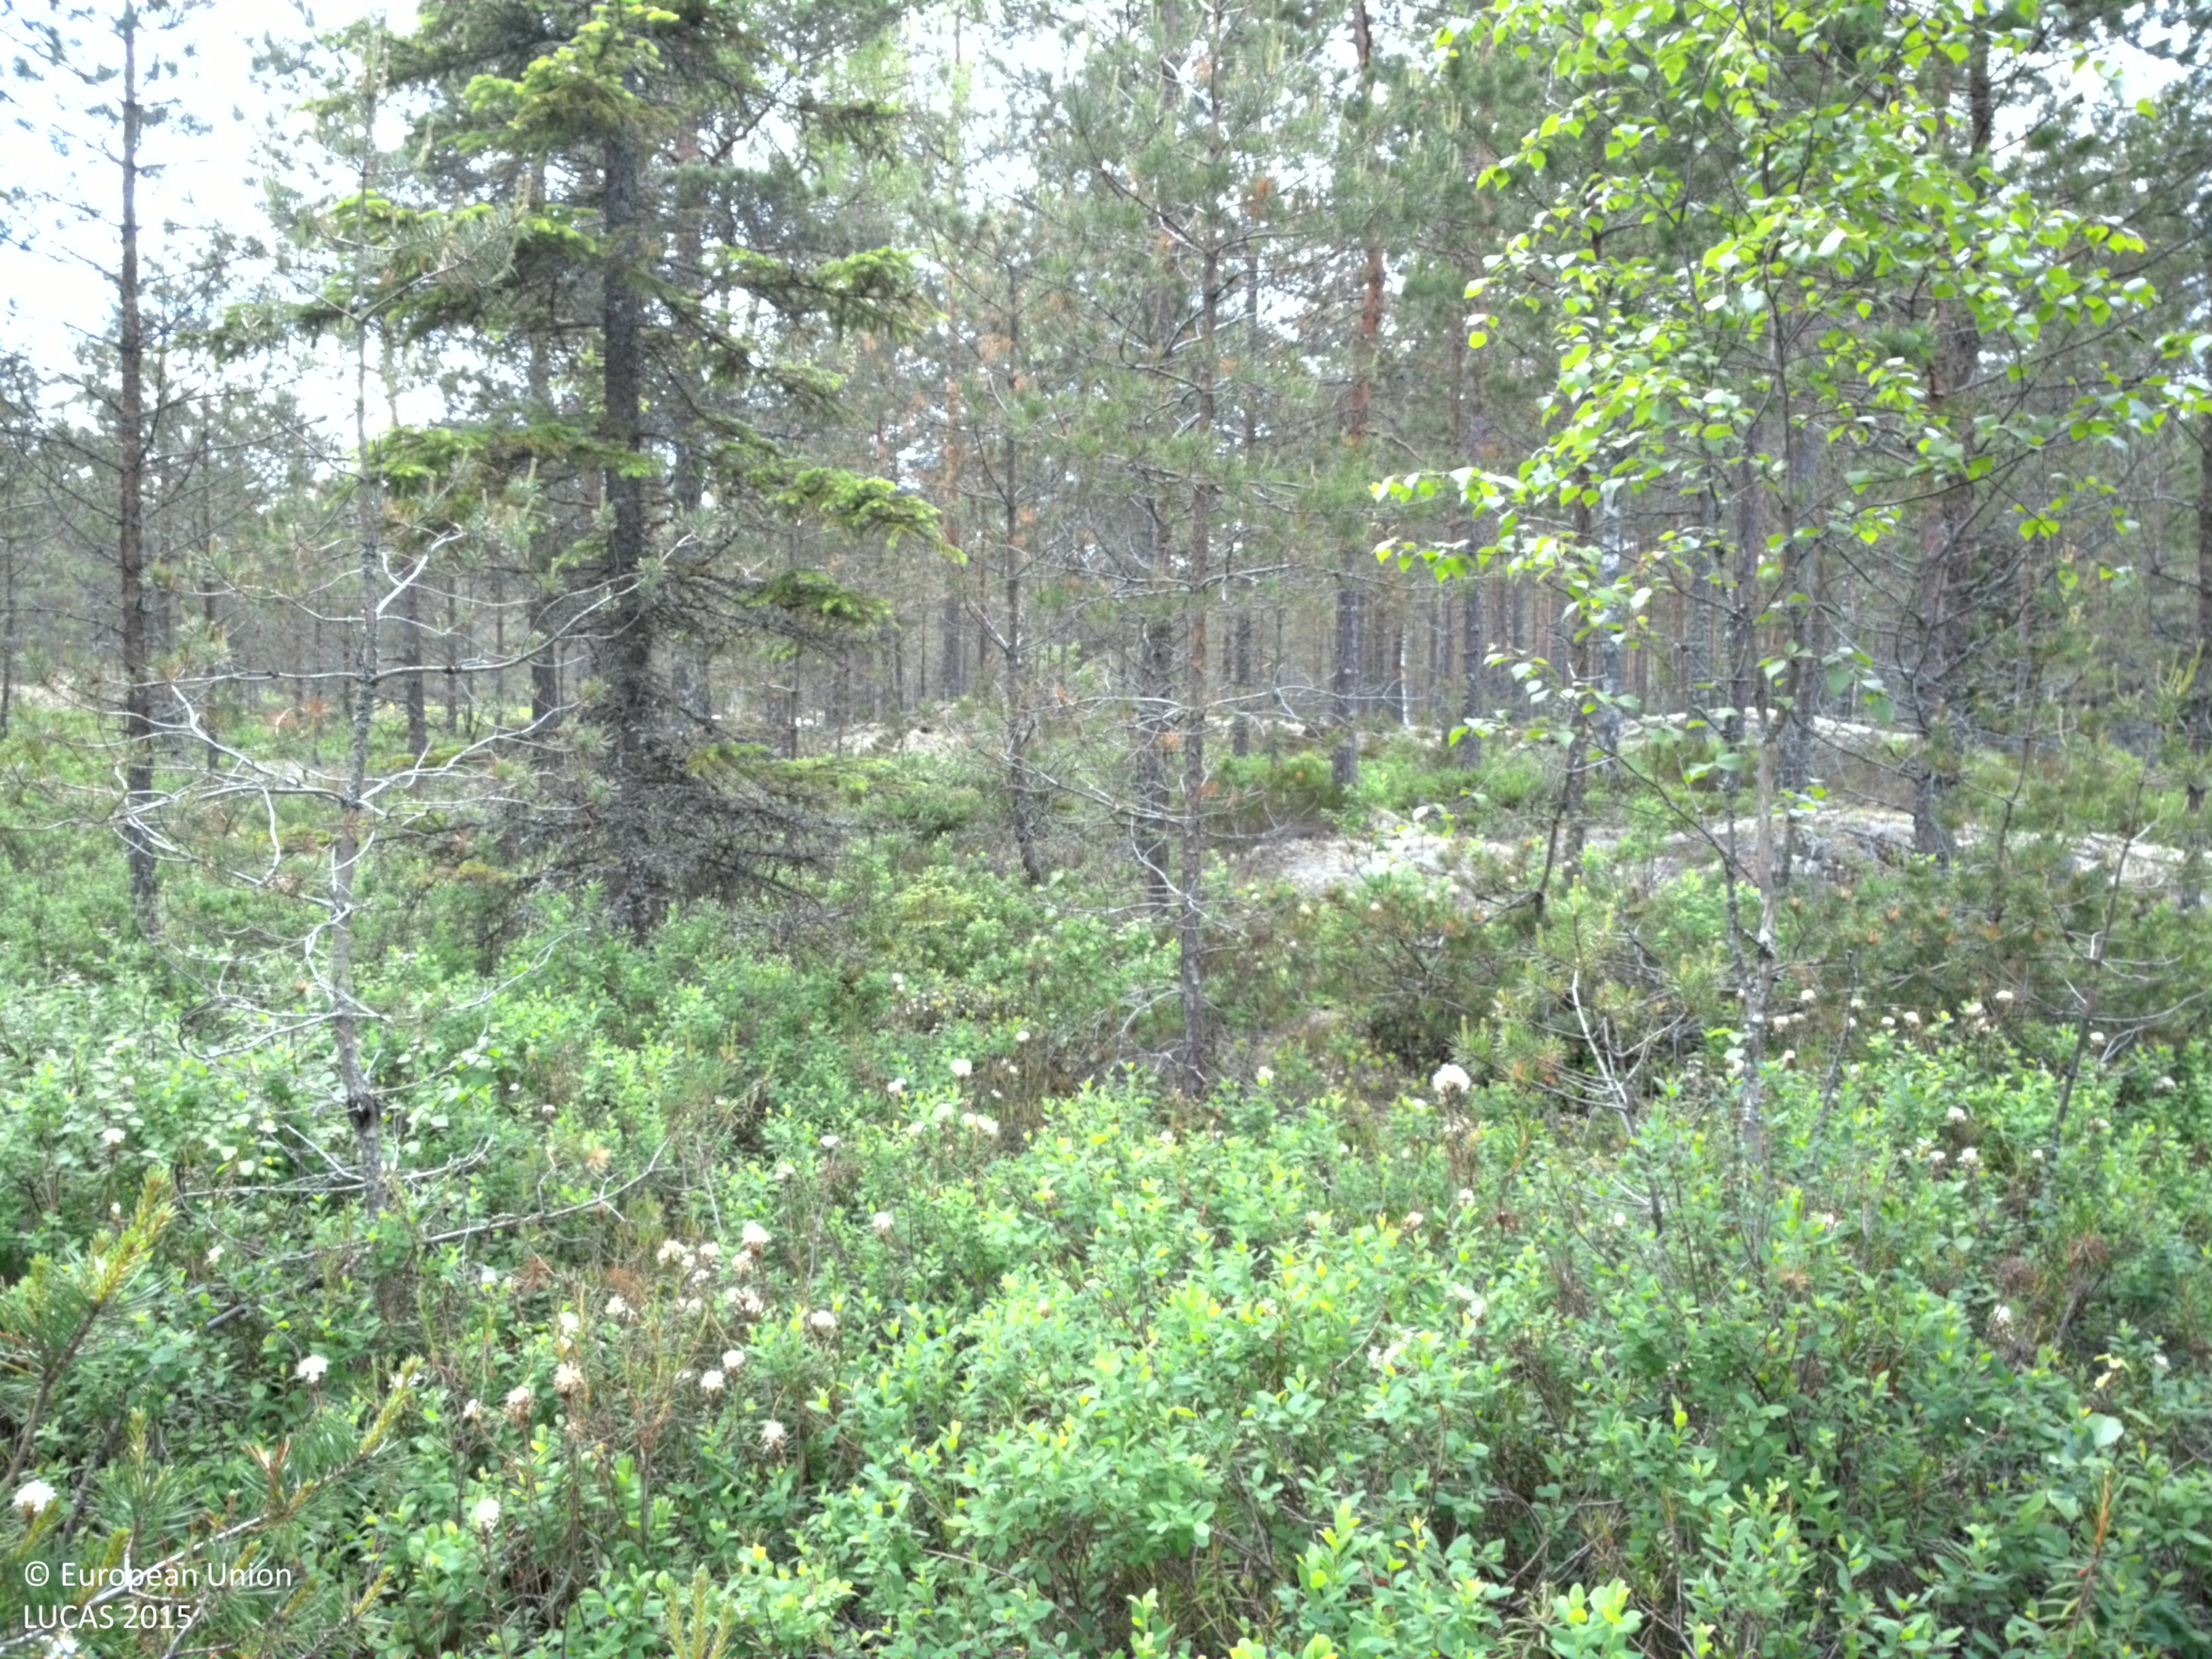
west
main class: Woodland
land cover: Pine dominated coniferous woodland
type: boreal forest
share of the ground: 25 - 50 %
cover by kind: coniferous forest trees 45 %, lichens and mosses 30 %, shrubs 20 %, broadleaved forest trees 5 %
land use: Forestry
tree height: > 5 m
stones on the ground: < 10 %
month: June
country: SE
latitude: 59.9977
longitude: 17.1817
